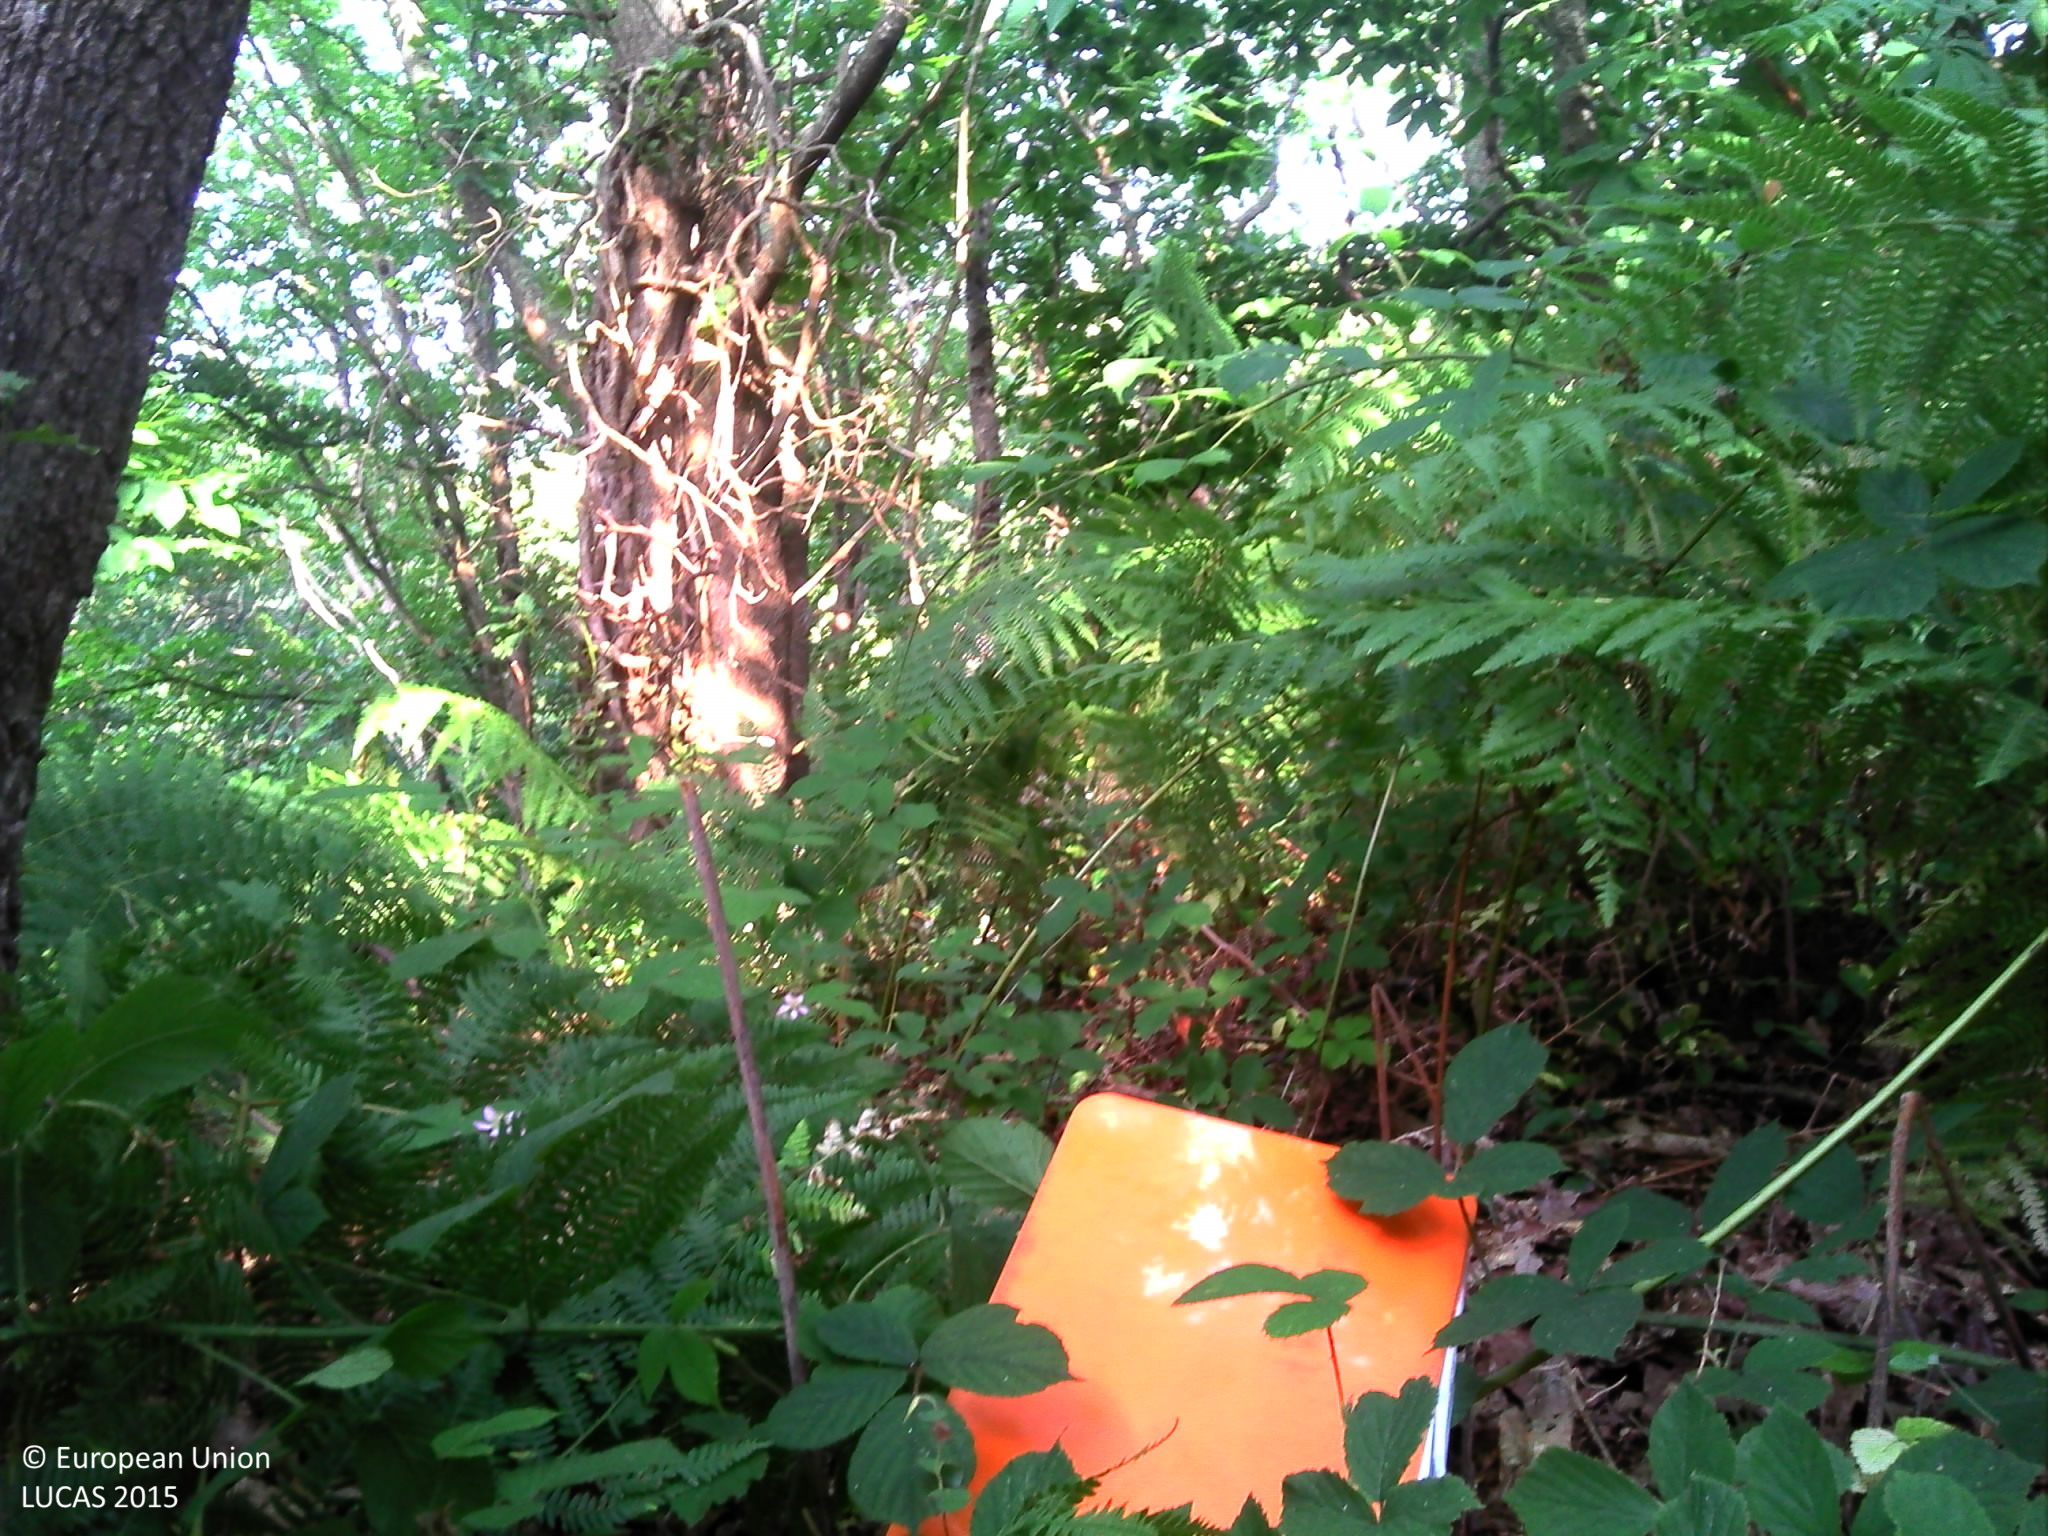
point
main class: Woodland
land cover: Broadleaved woodland
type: acidophilous oak and oak-birch forest
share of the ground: > 75 %
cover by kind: broadleaved forest trees 65 %, herbaceous plants 20 %, unconsolidated bare surface 10 %, lichens and mosses 5 %
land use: Forestry
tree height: > 5 m
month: July
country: FR
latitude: 48.8120
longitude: -3.4933
